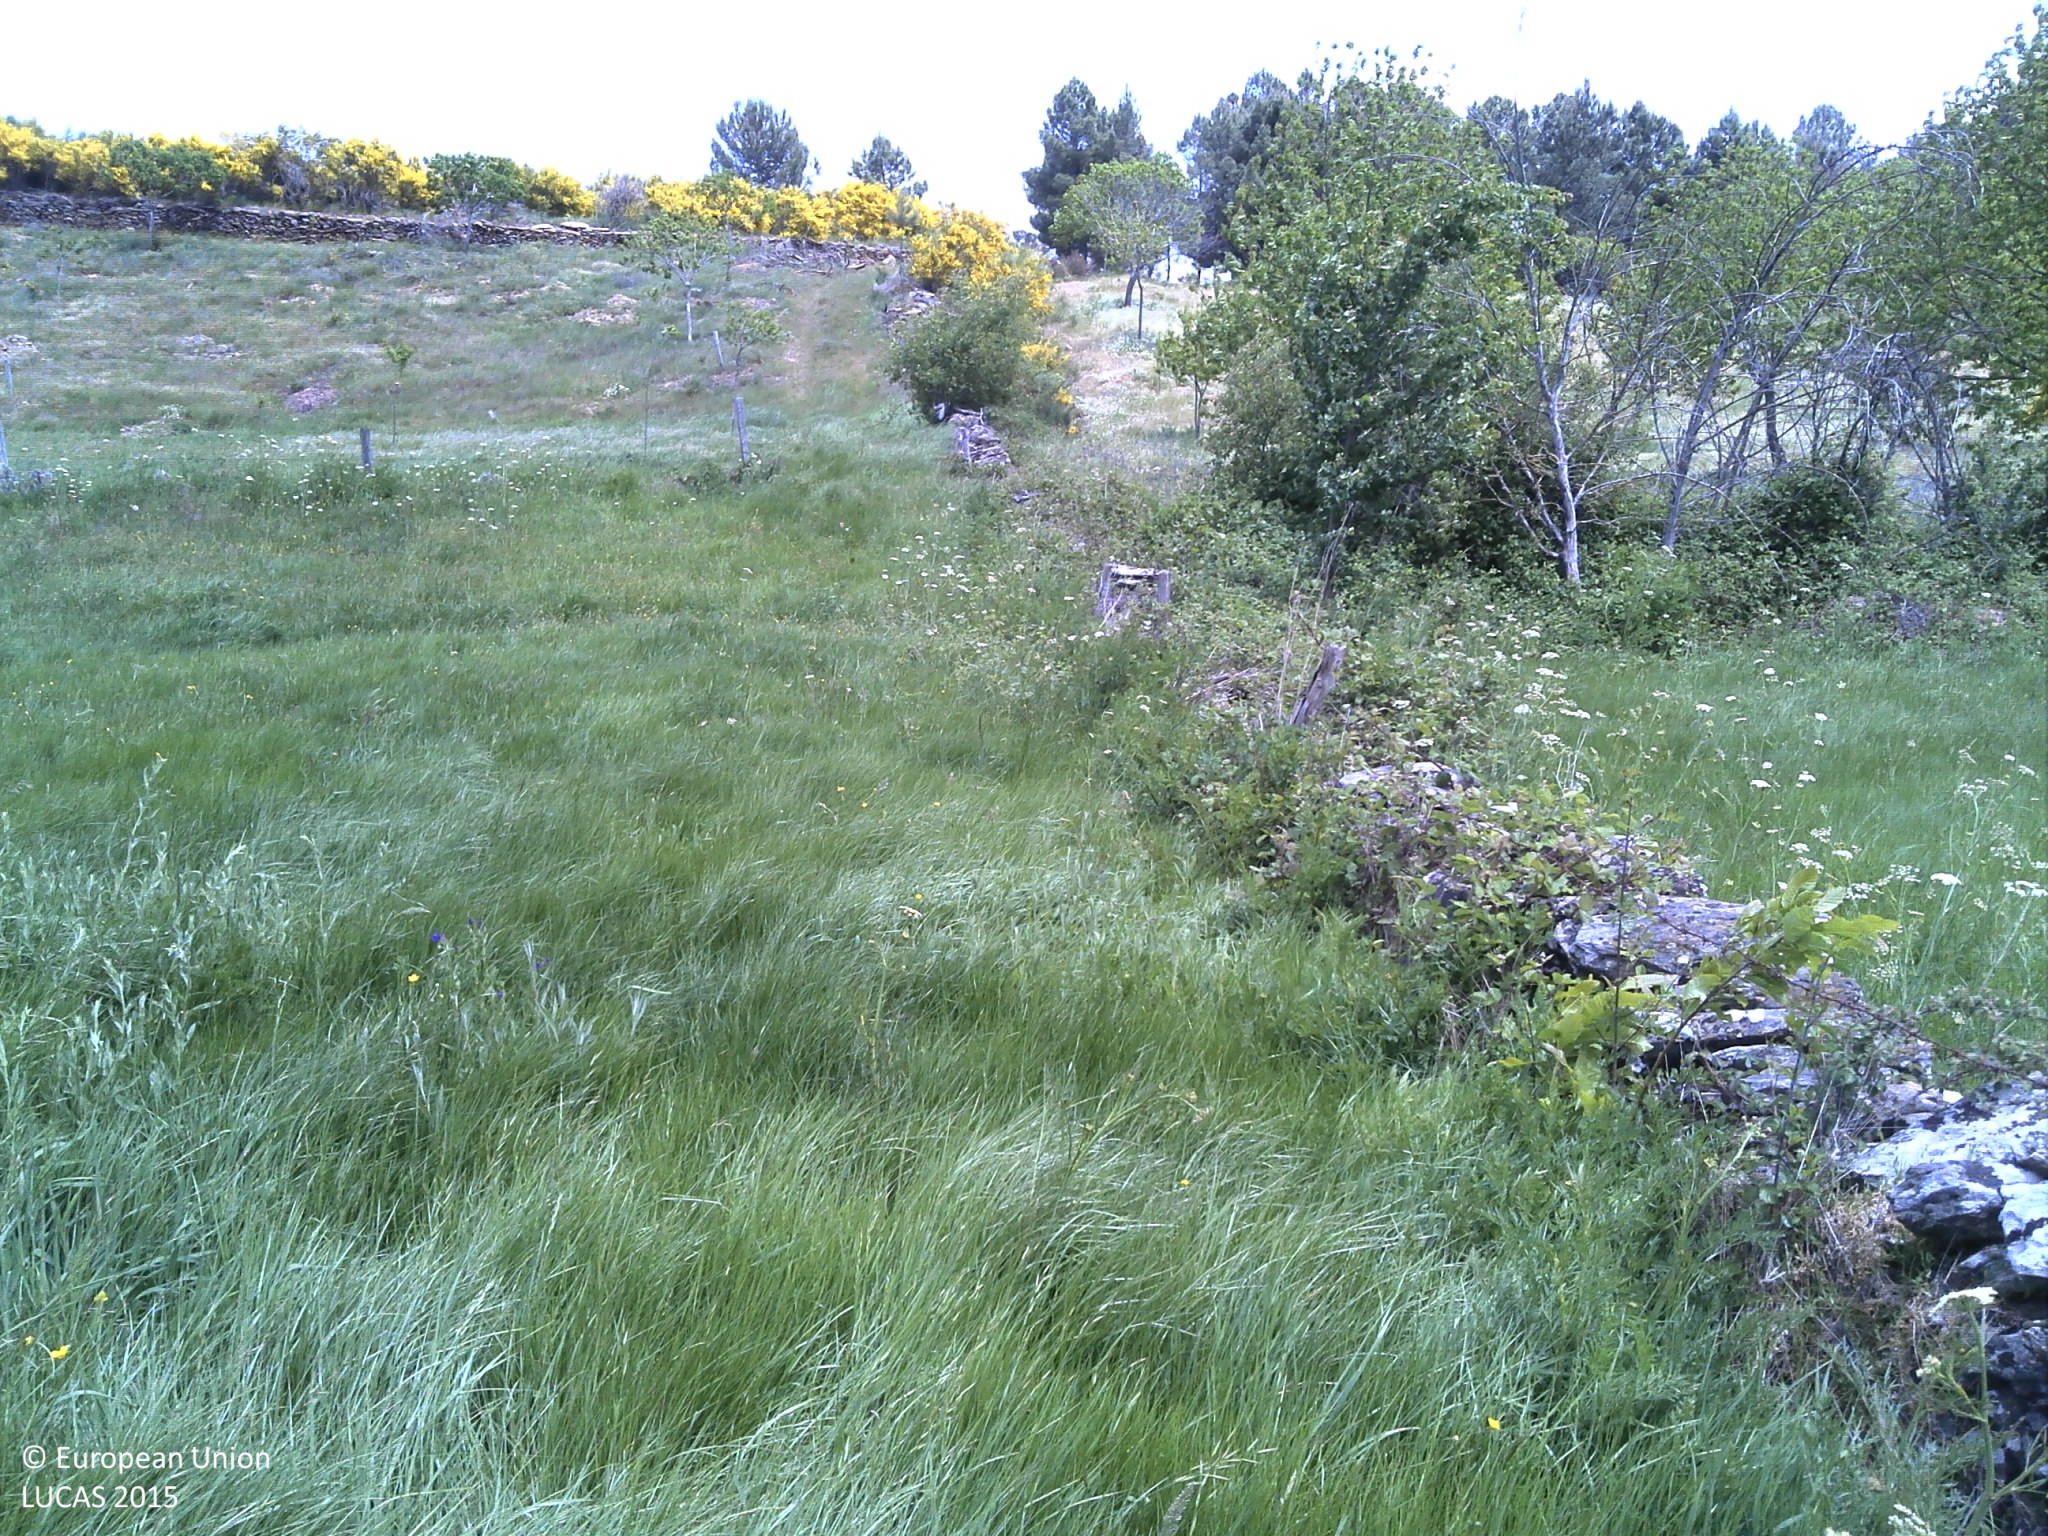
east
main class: Grassland
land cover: Grassland without tree/shrub cover
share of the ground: > 75 %
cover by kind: herbaceous plants 100 %
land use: Agriculture (excluding fallow land and kitchen gardens)
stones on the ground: < 10 %
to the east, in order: Grassland without tree/shrub cover; Fences; Nuts trees; Tracks; Dry stone walls; Shrubland without tree cover; Shrubland with sparse tree cover; Dry stone walls; Shruby margins; Tracks; Shruby margins; Paved roads, cycling and walking lanes; Grass margins; Shrubland without tree cover; Shrubland with sparse tree cover
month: May
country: PT
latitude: 41.5277
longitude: -7.4685
